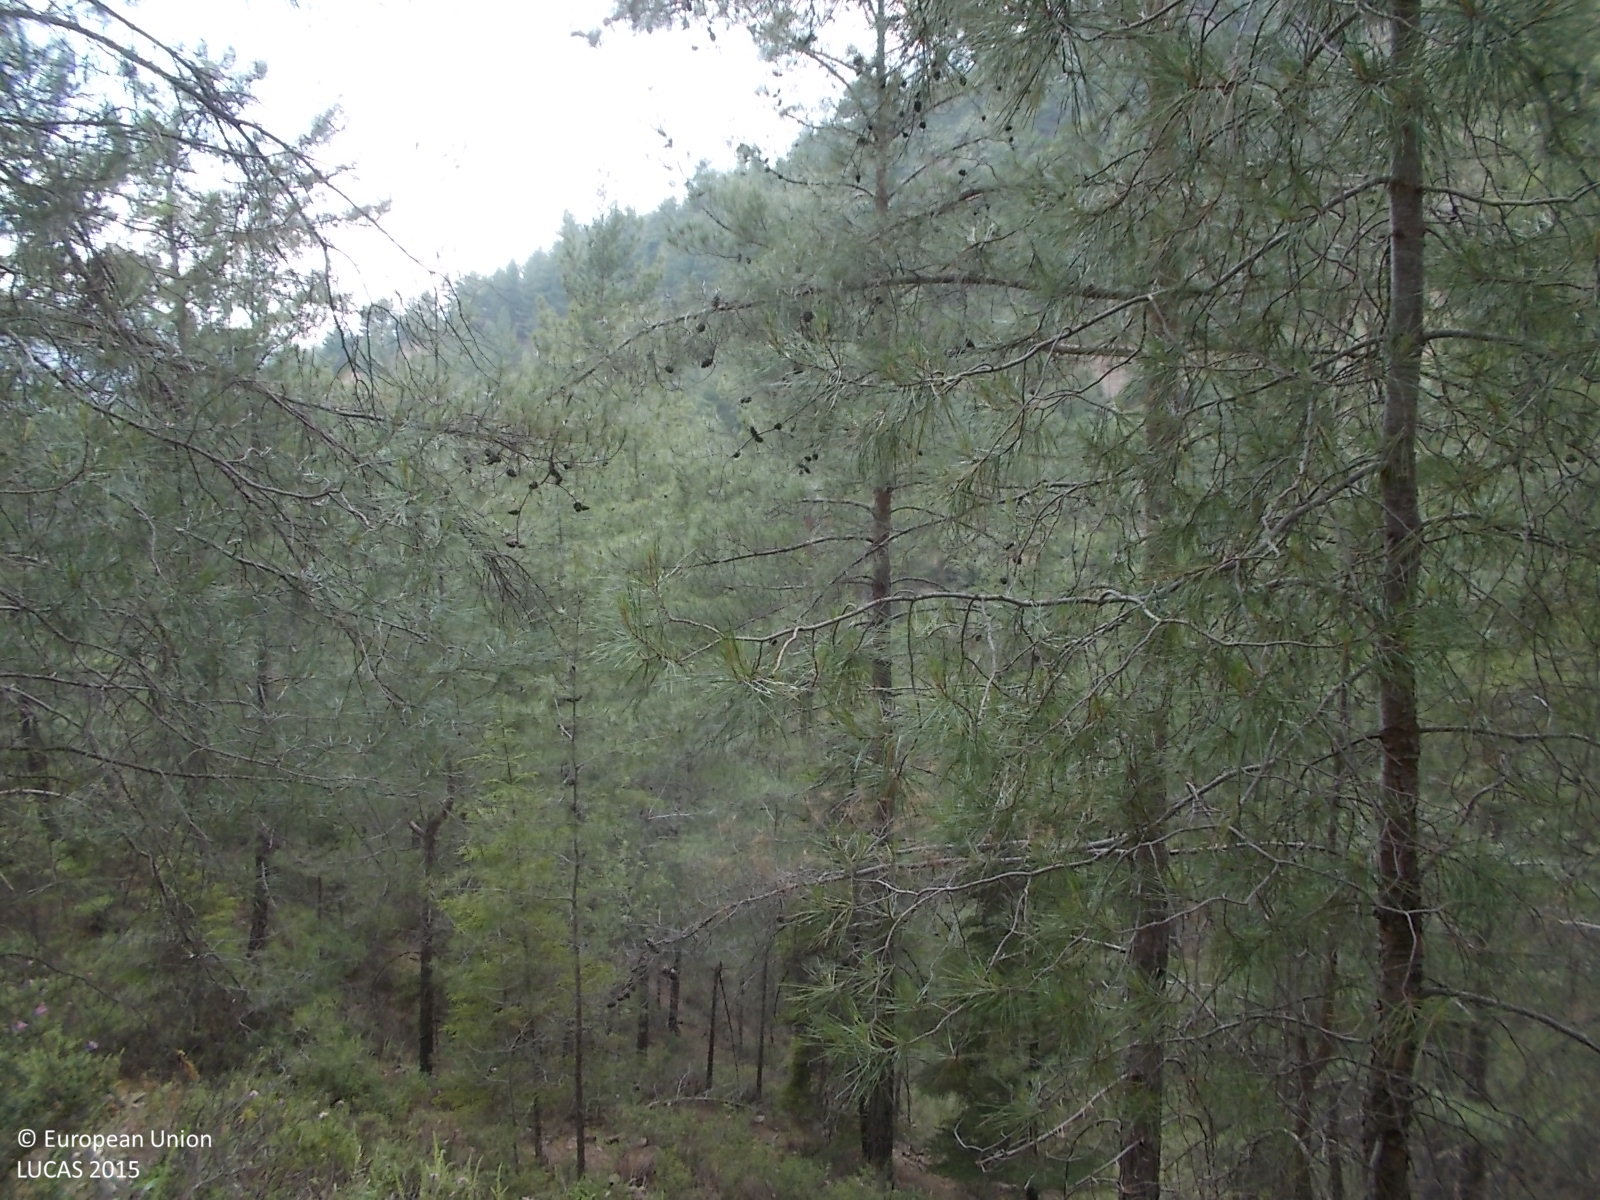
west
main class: Woodland
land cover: Pine dominated coniferous woodland
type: coniferous forest of the mediterranean region
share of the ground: > 75 %
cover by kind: coniferous forest trees 95 %, shrubs 5 %
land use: Forestry
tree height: > 5 m
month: June
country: CY
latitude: 35.0397
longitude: 32.6220
